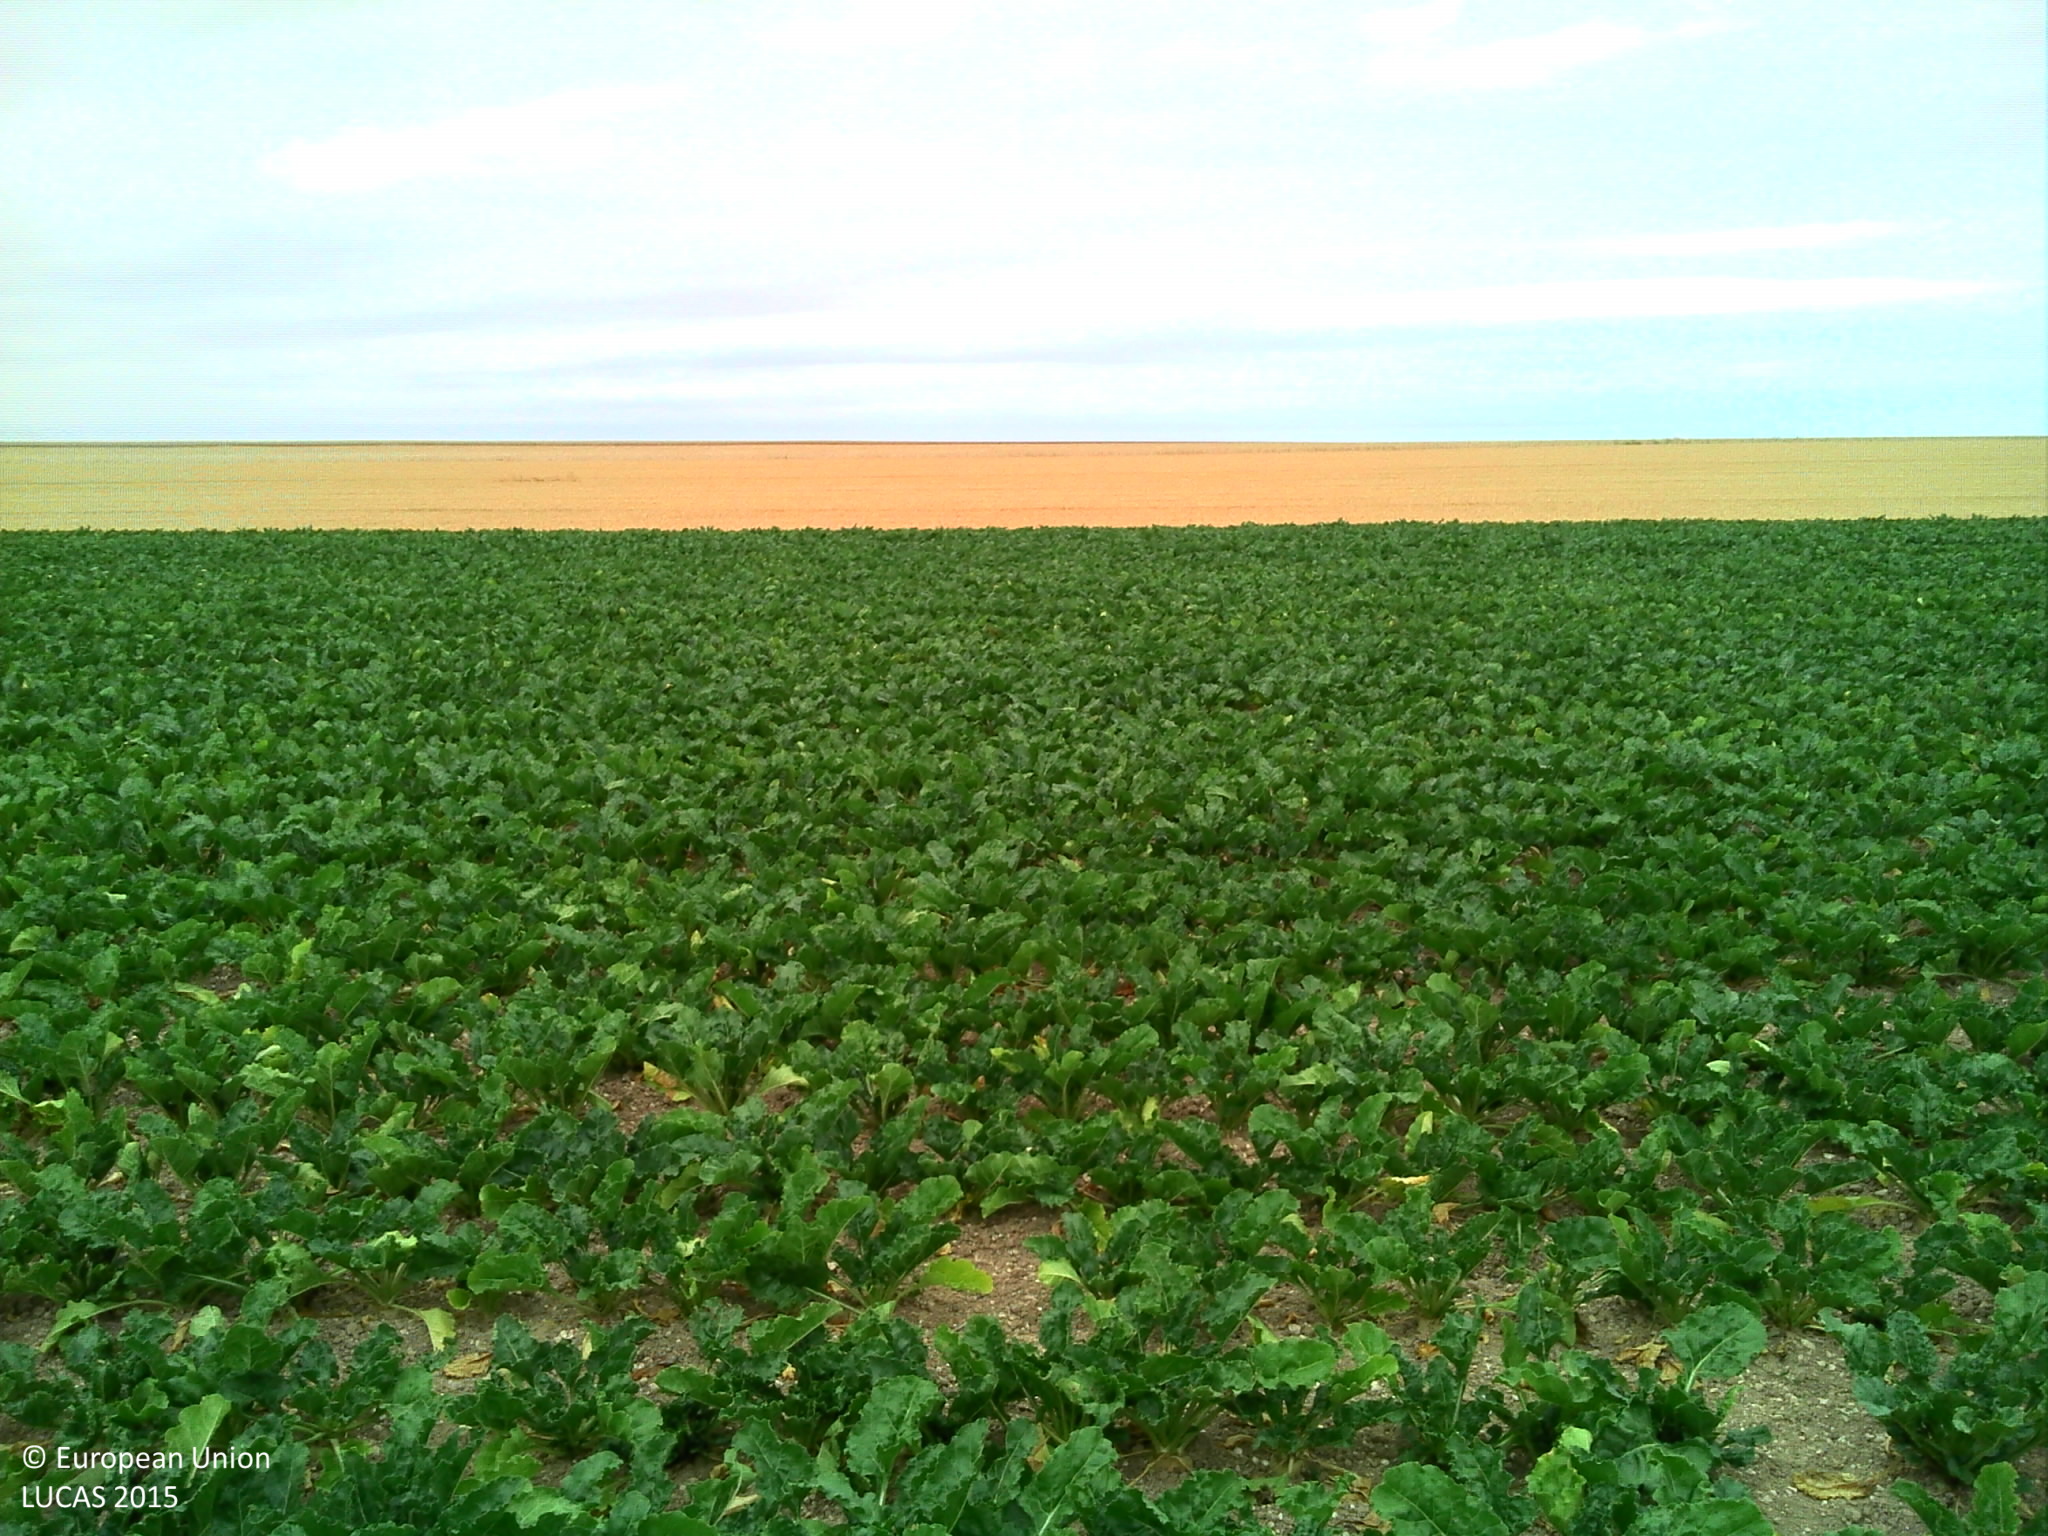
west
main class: Cropland
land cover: Sugar beet
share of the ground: > 75 %
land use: Agriculture (excluding fallow land and kitchen gardens)
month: July
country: FR
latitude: 49.3995
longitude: 4.0836
